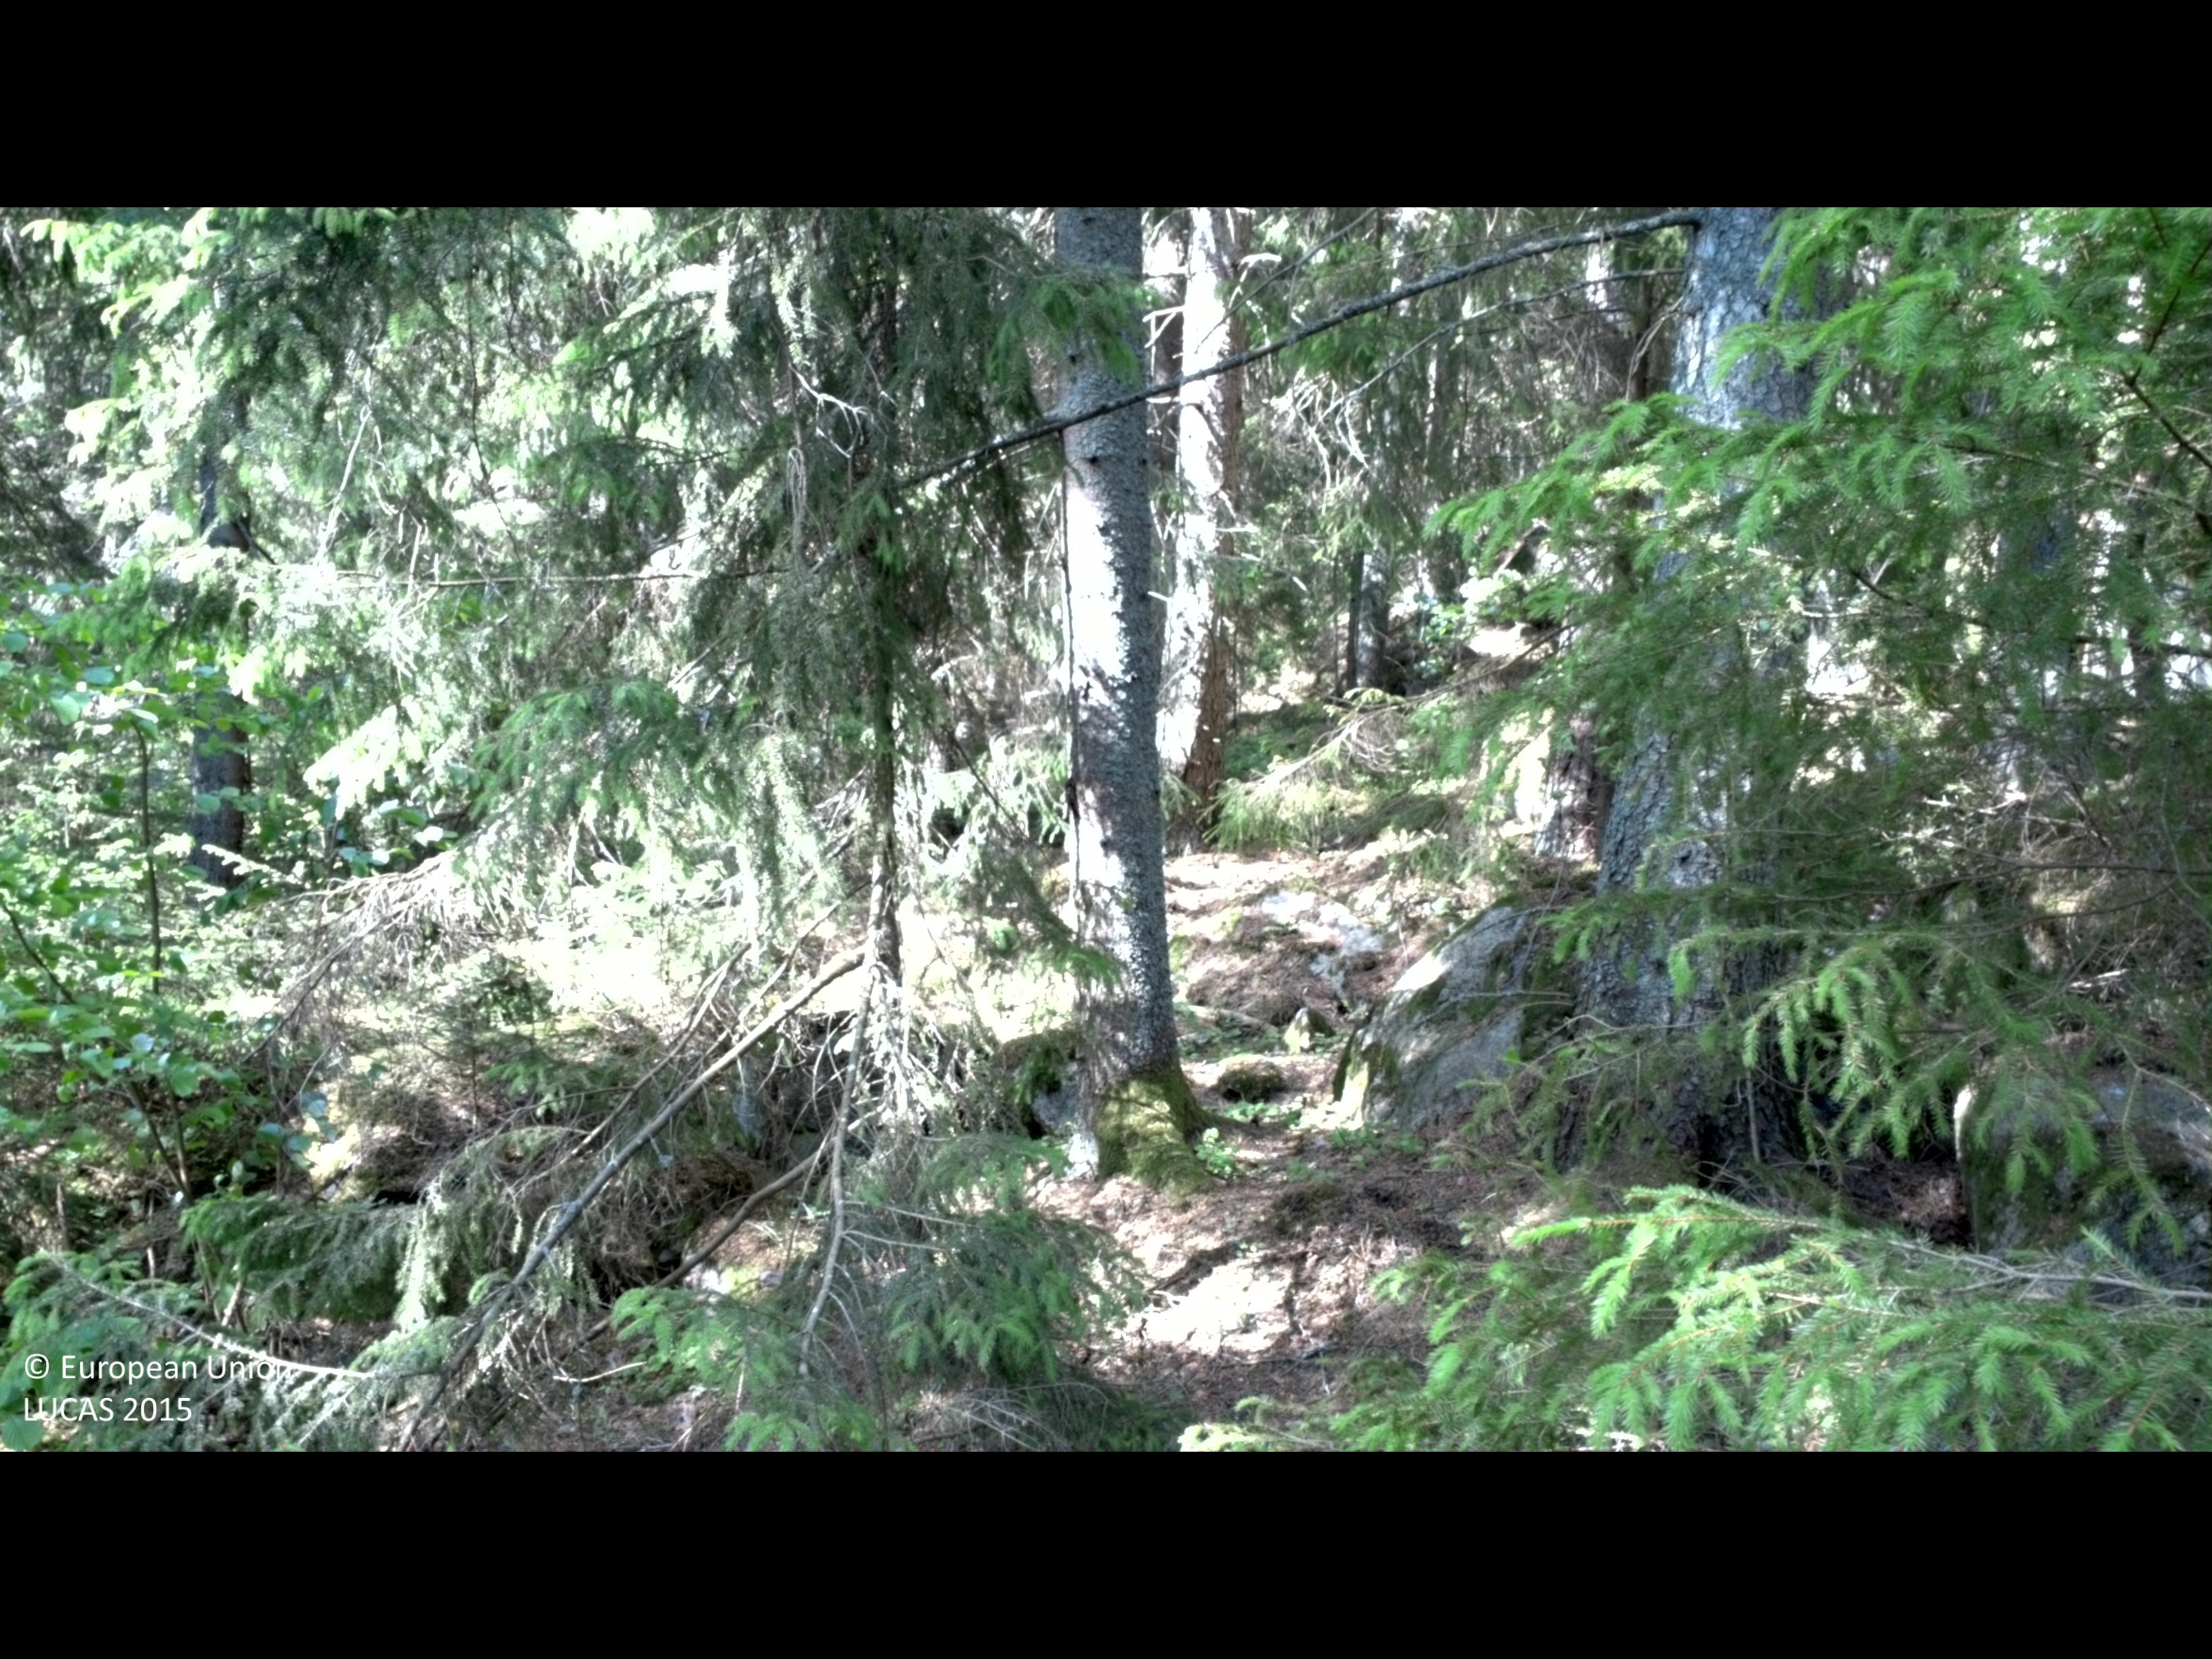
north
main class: Woodland
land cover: Spruce dominated coniferous woodland
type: boreal forest
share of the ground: 50 - 75 %
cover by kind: coniferous forest trees 60 %, herbaceous plants 30 %, shrubs 5 %, lichens and mosses 5 %
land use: Forestry
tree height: > 5 m
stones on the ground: < 10 %
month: June
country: SE
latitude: 57.8218
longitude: 16.2436
